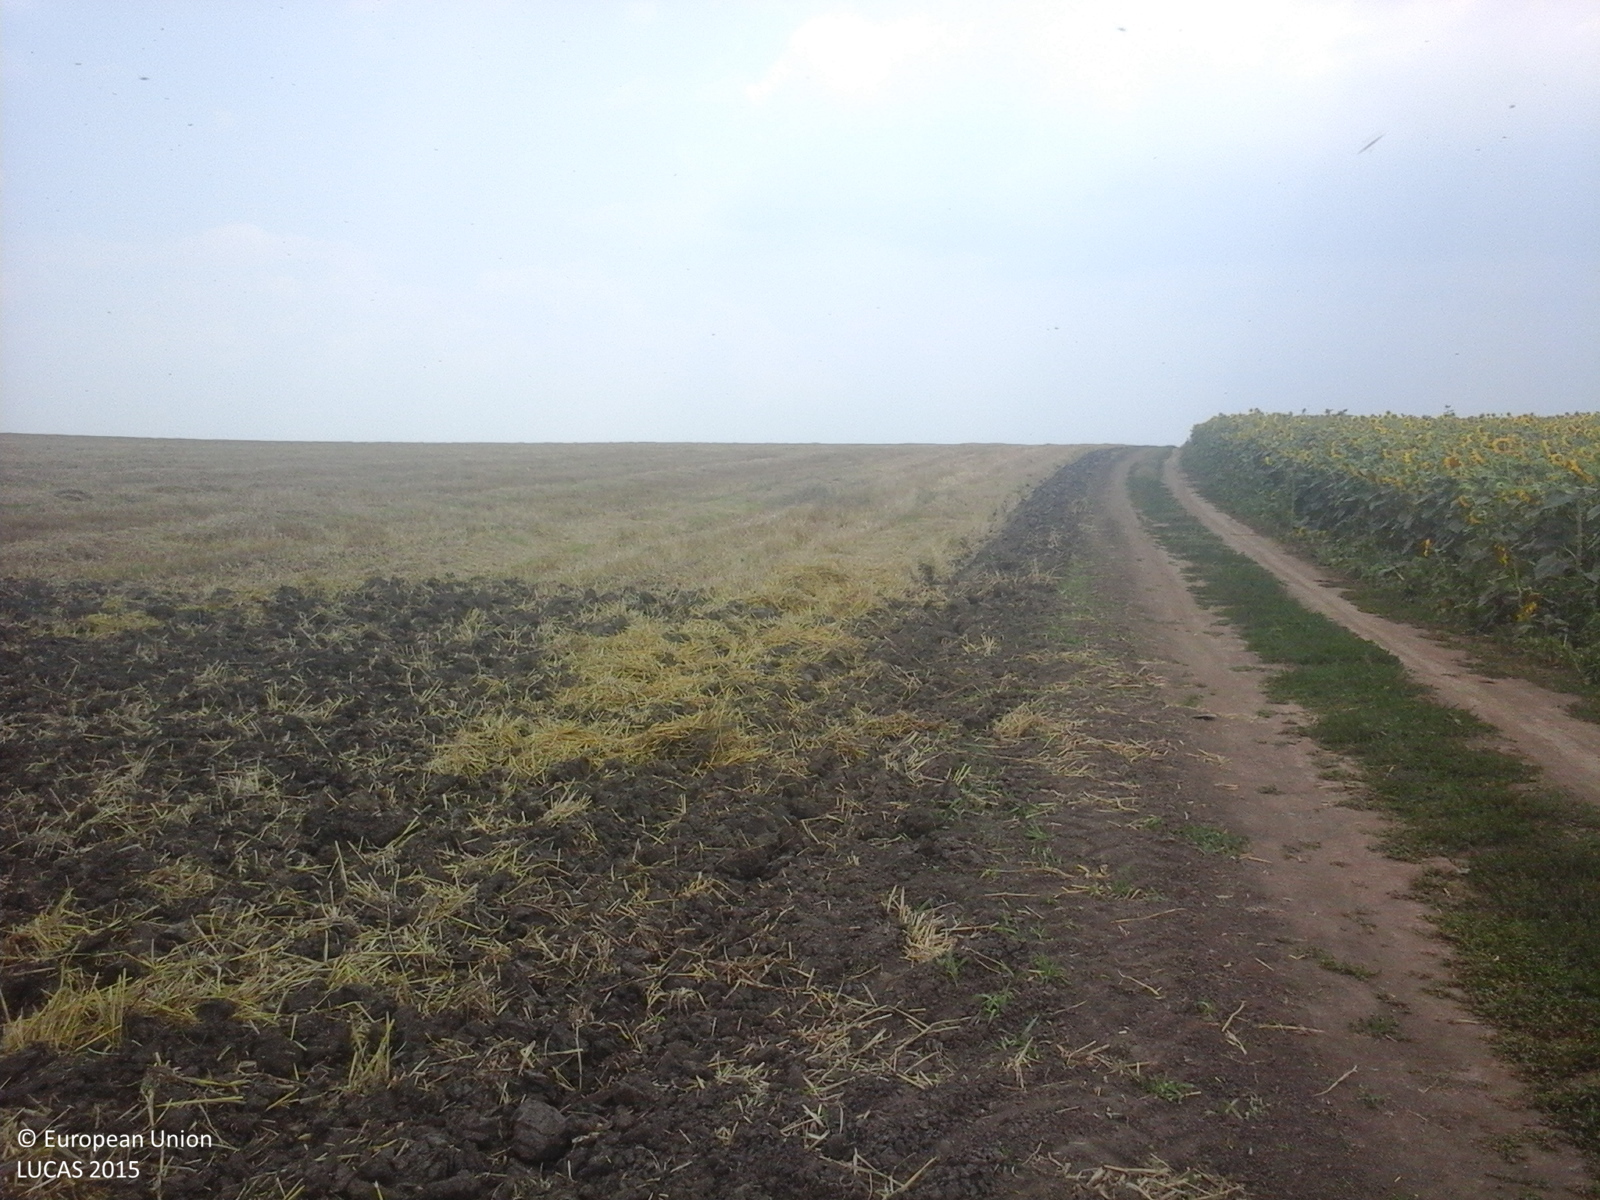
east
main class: Cropland
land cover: Barley
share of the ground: < 10 %
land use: Agriculture (excluding fallow land and kitchen gardens)
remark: Harvested field
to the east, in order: Barley
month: July
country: RO
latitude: 43.7841
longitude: 25.1244
